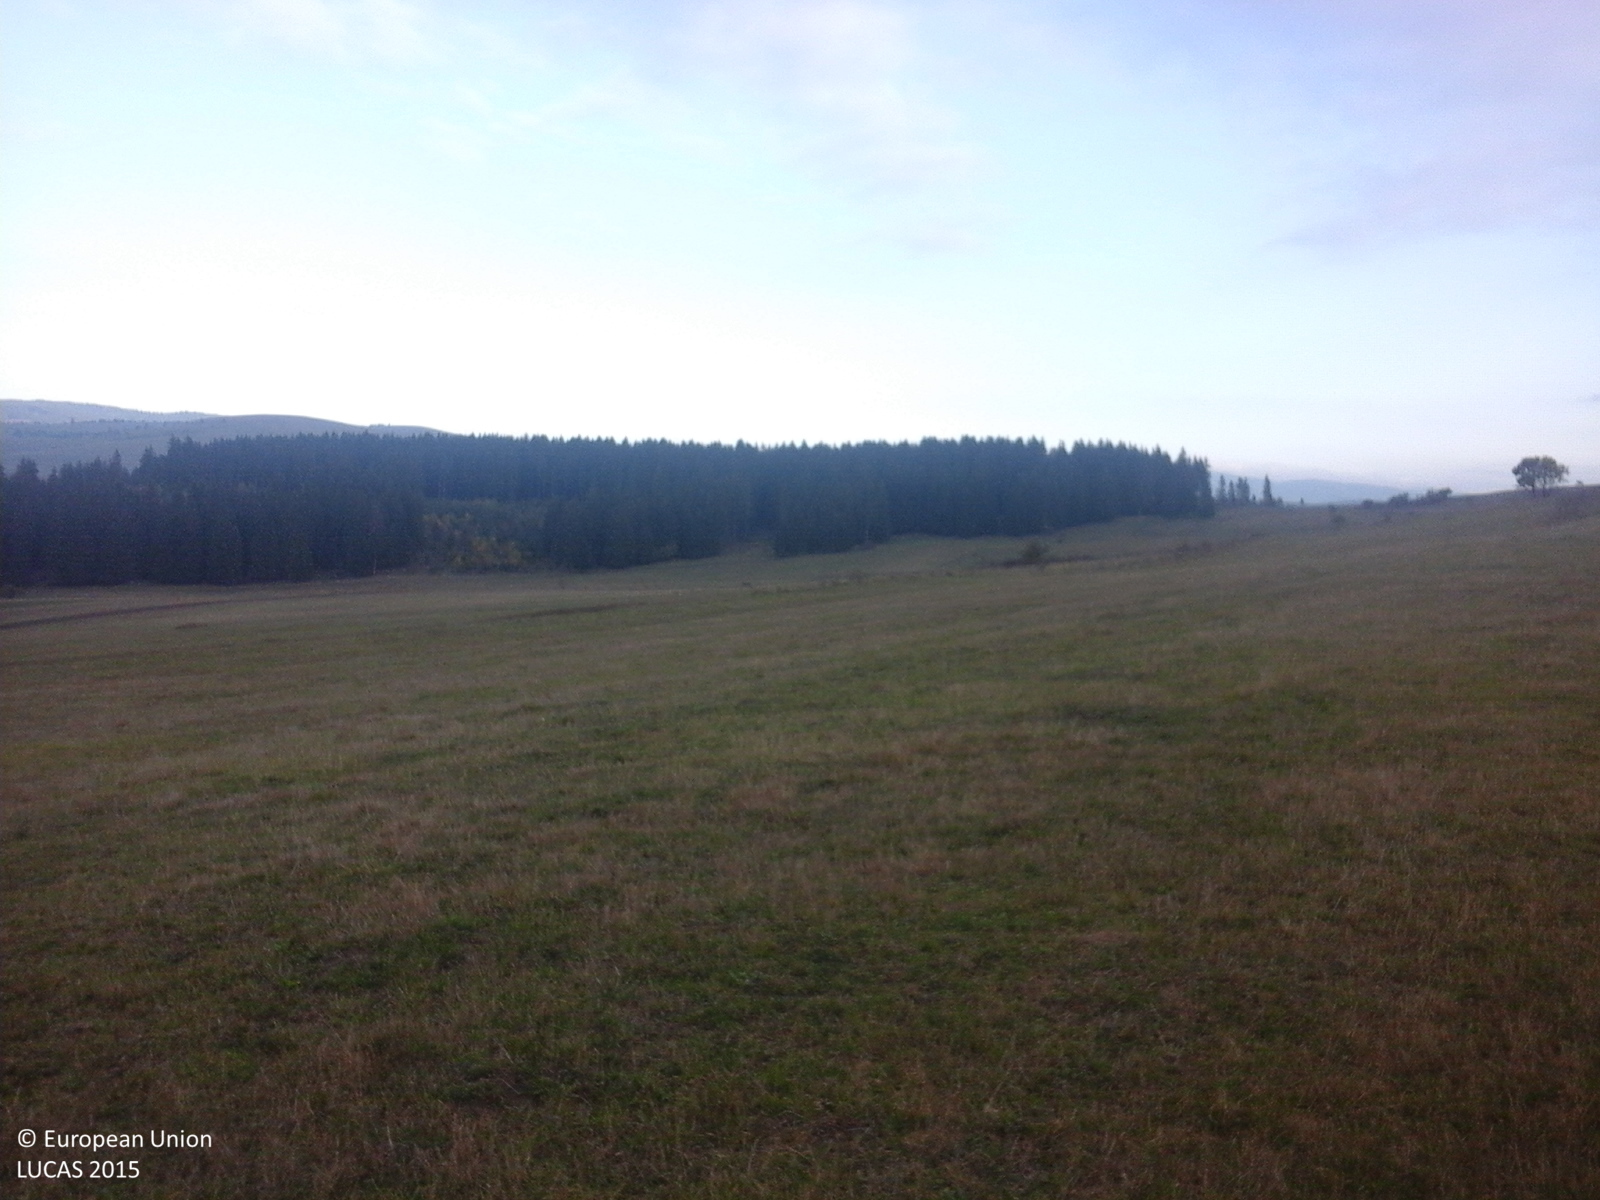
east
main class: Grassland
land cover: Grassland without tree/shrub cover
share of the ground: > 75 %
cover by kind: herbaceous plants 100 %
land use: Agriculture (excluding fallow land and kitchen gardens)
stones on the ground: < 10 %
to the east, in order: Grassland without tree/shrub cover; Tracks; Grassland without tree/shrub cover; Tracks; Grassland without tree/shrub cover
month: October
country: RO
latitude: 46.3379
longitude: 25.8223
